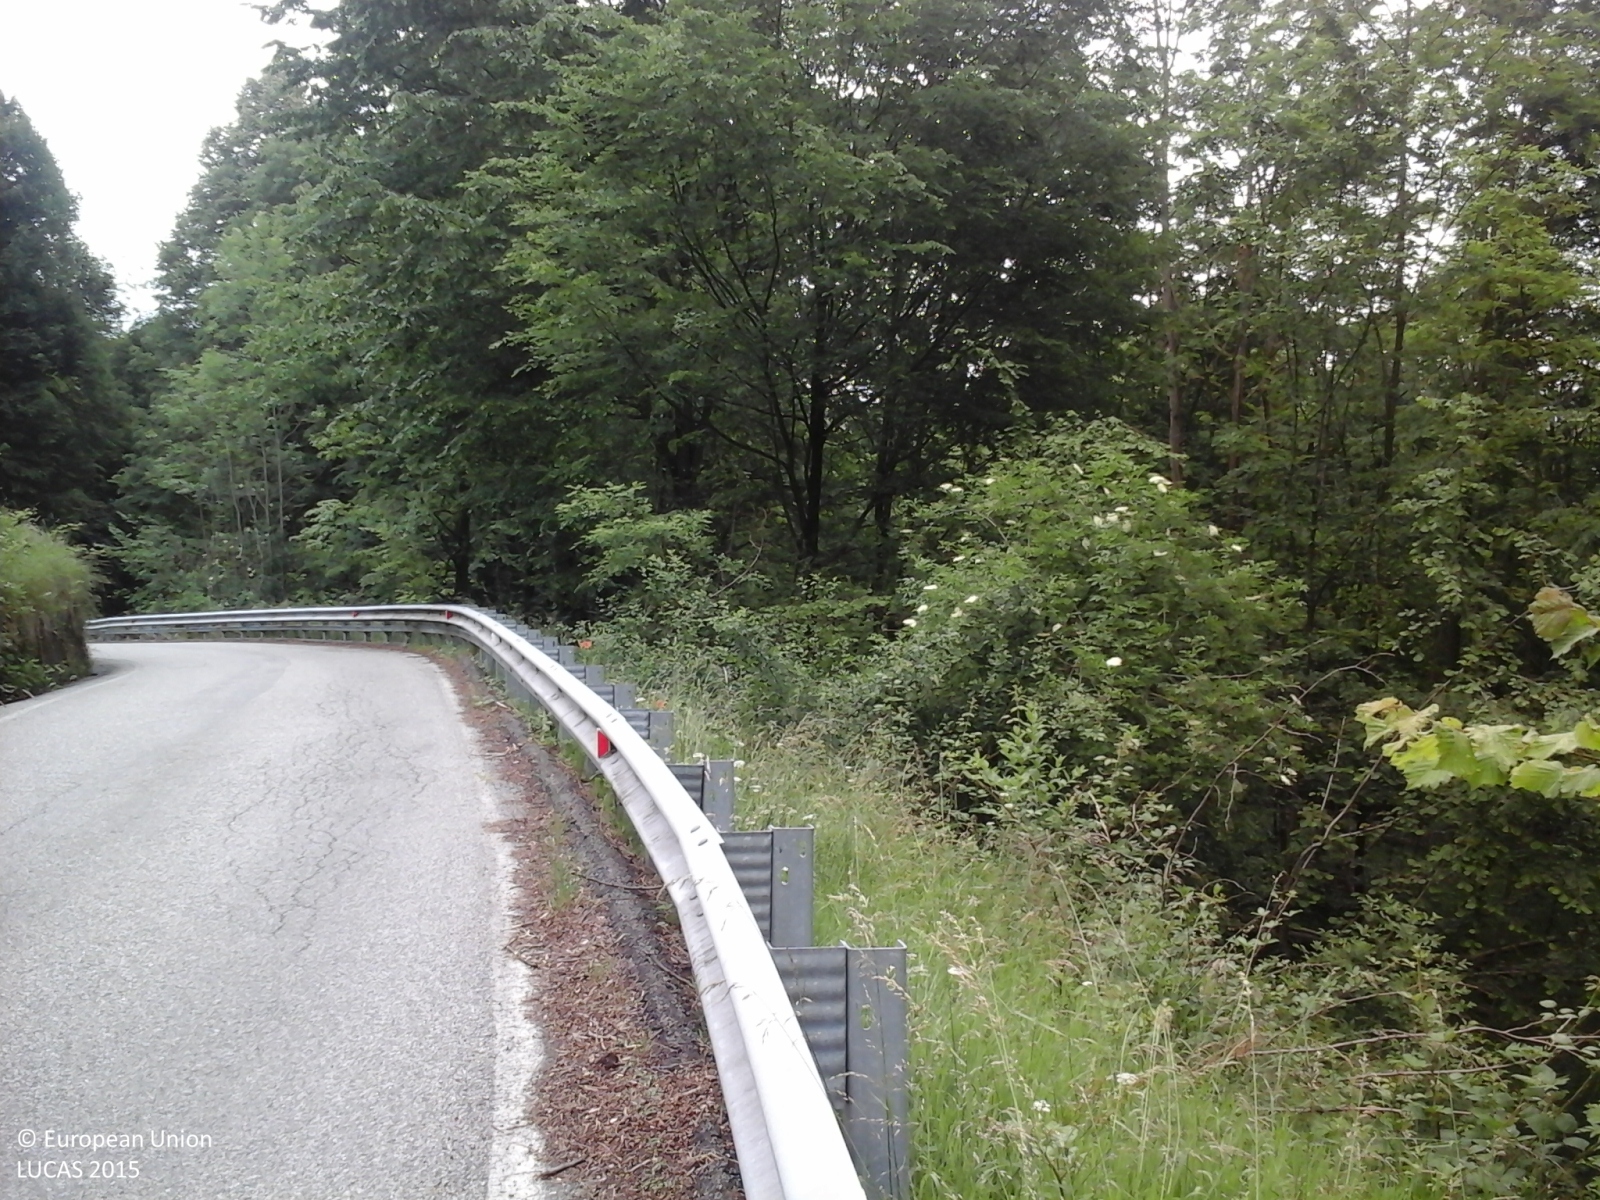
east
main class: Woodland
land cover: Broadleaved woodland
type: mesophytic deciduous forest
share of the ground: > 75 %
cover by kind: broadleaved forest trees 100 %
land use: Forestry
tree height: > 5 m
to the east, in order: Broadleaved woodland; Other bare soil; Broadleaved woodland; Other bare soil; Artificial constructions in urban areas; Other bare soil
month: May
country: IT
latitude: 45.6876
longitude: 8.2179
